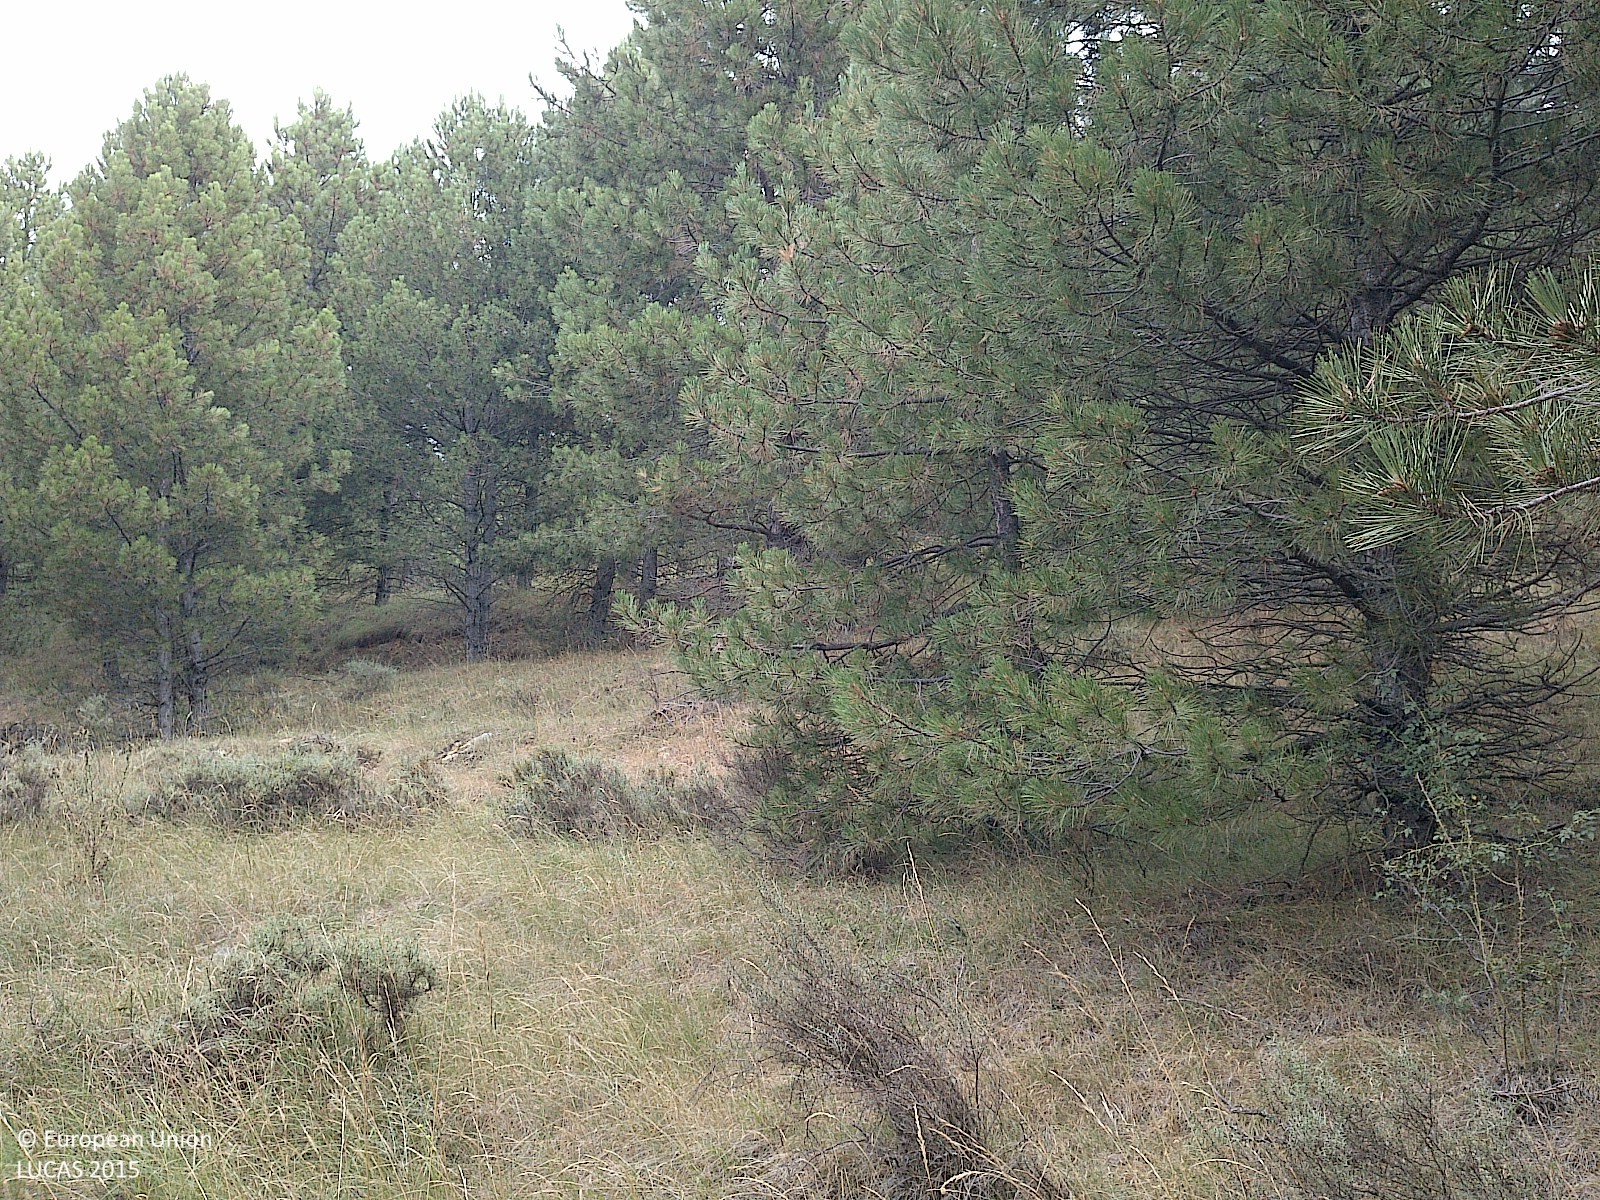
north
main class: Woodland
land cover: Pine dominated coniferous woodland
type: coniferous forest of the mediterranean region
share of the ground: 50 - 75 %
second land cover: Grassland without tree/shrub cover
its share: 50 - 75 %
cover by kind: coniferous forest trees 60 %, herbaceous plants 35 %, shrubs 5 %
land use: Forestry
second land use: Agriculture (excluding fallow land and kitchen gardens)
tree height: < 5 m
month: July
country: ES
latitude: 42.0500
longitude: -2.2781
